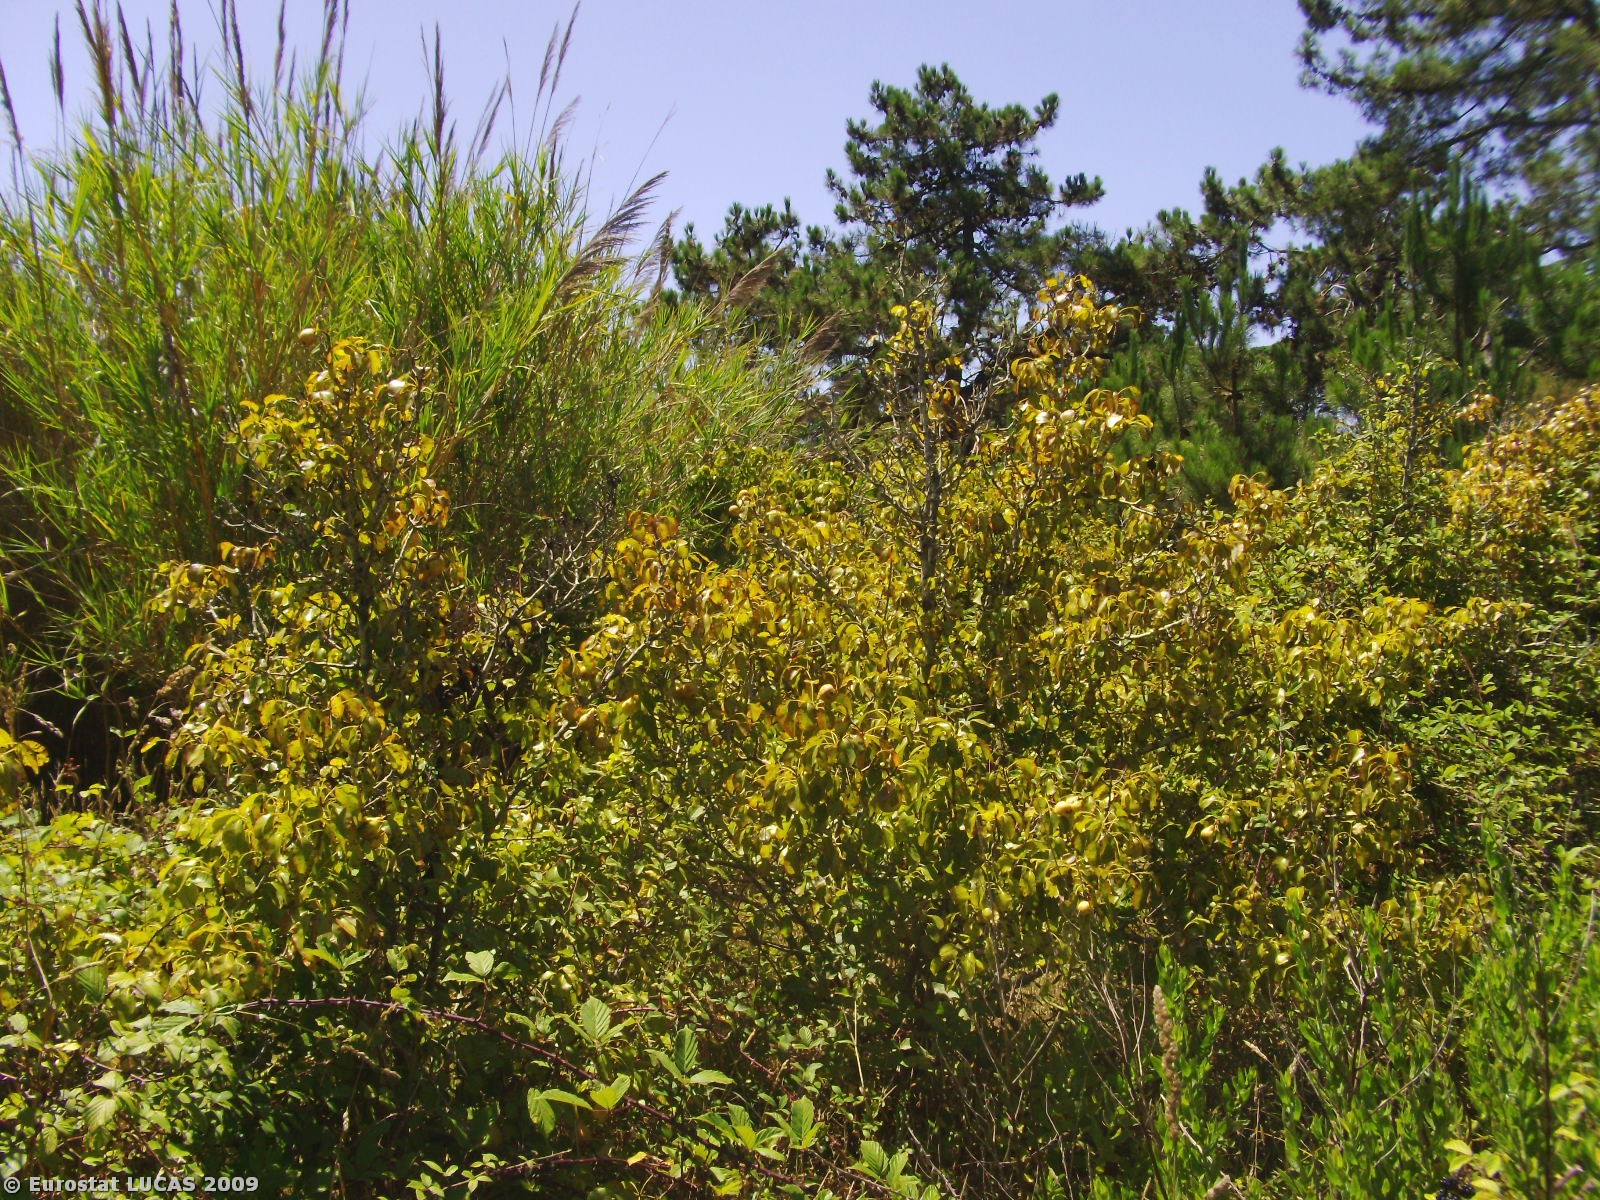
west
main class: Shrubland
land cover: Shrubland with sparse tree cover
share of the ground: > 75 %
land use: Unused
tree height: < 5 m
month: July
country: PT
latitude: 39.2540
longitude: -9.3162
